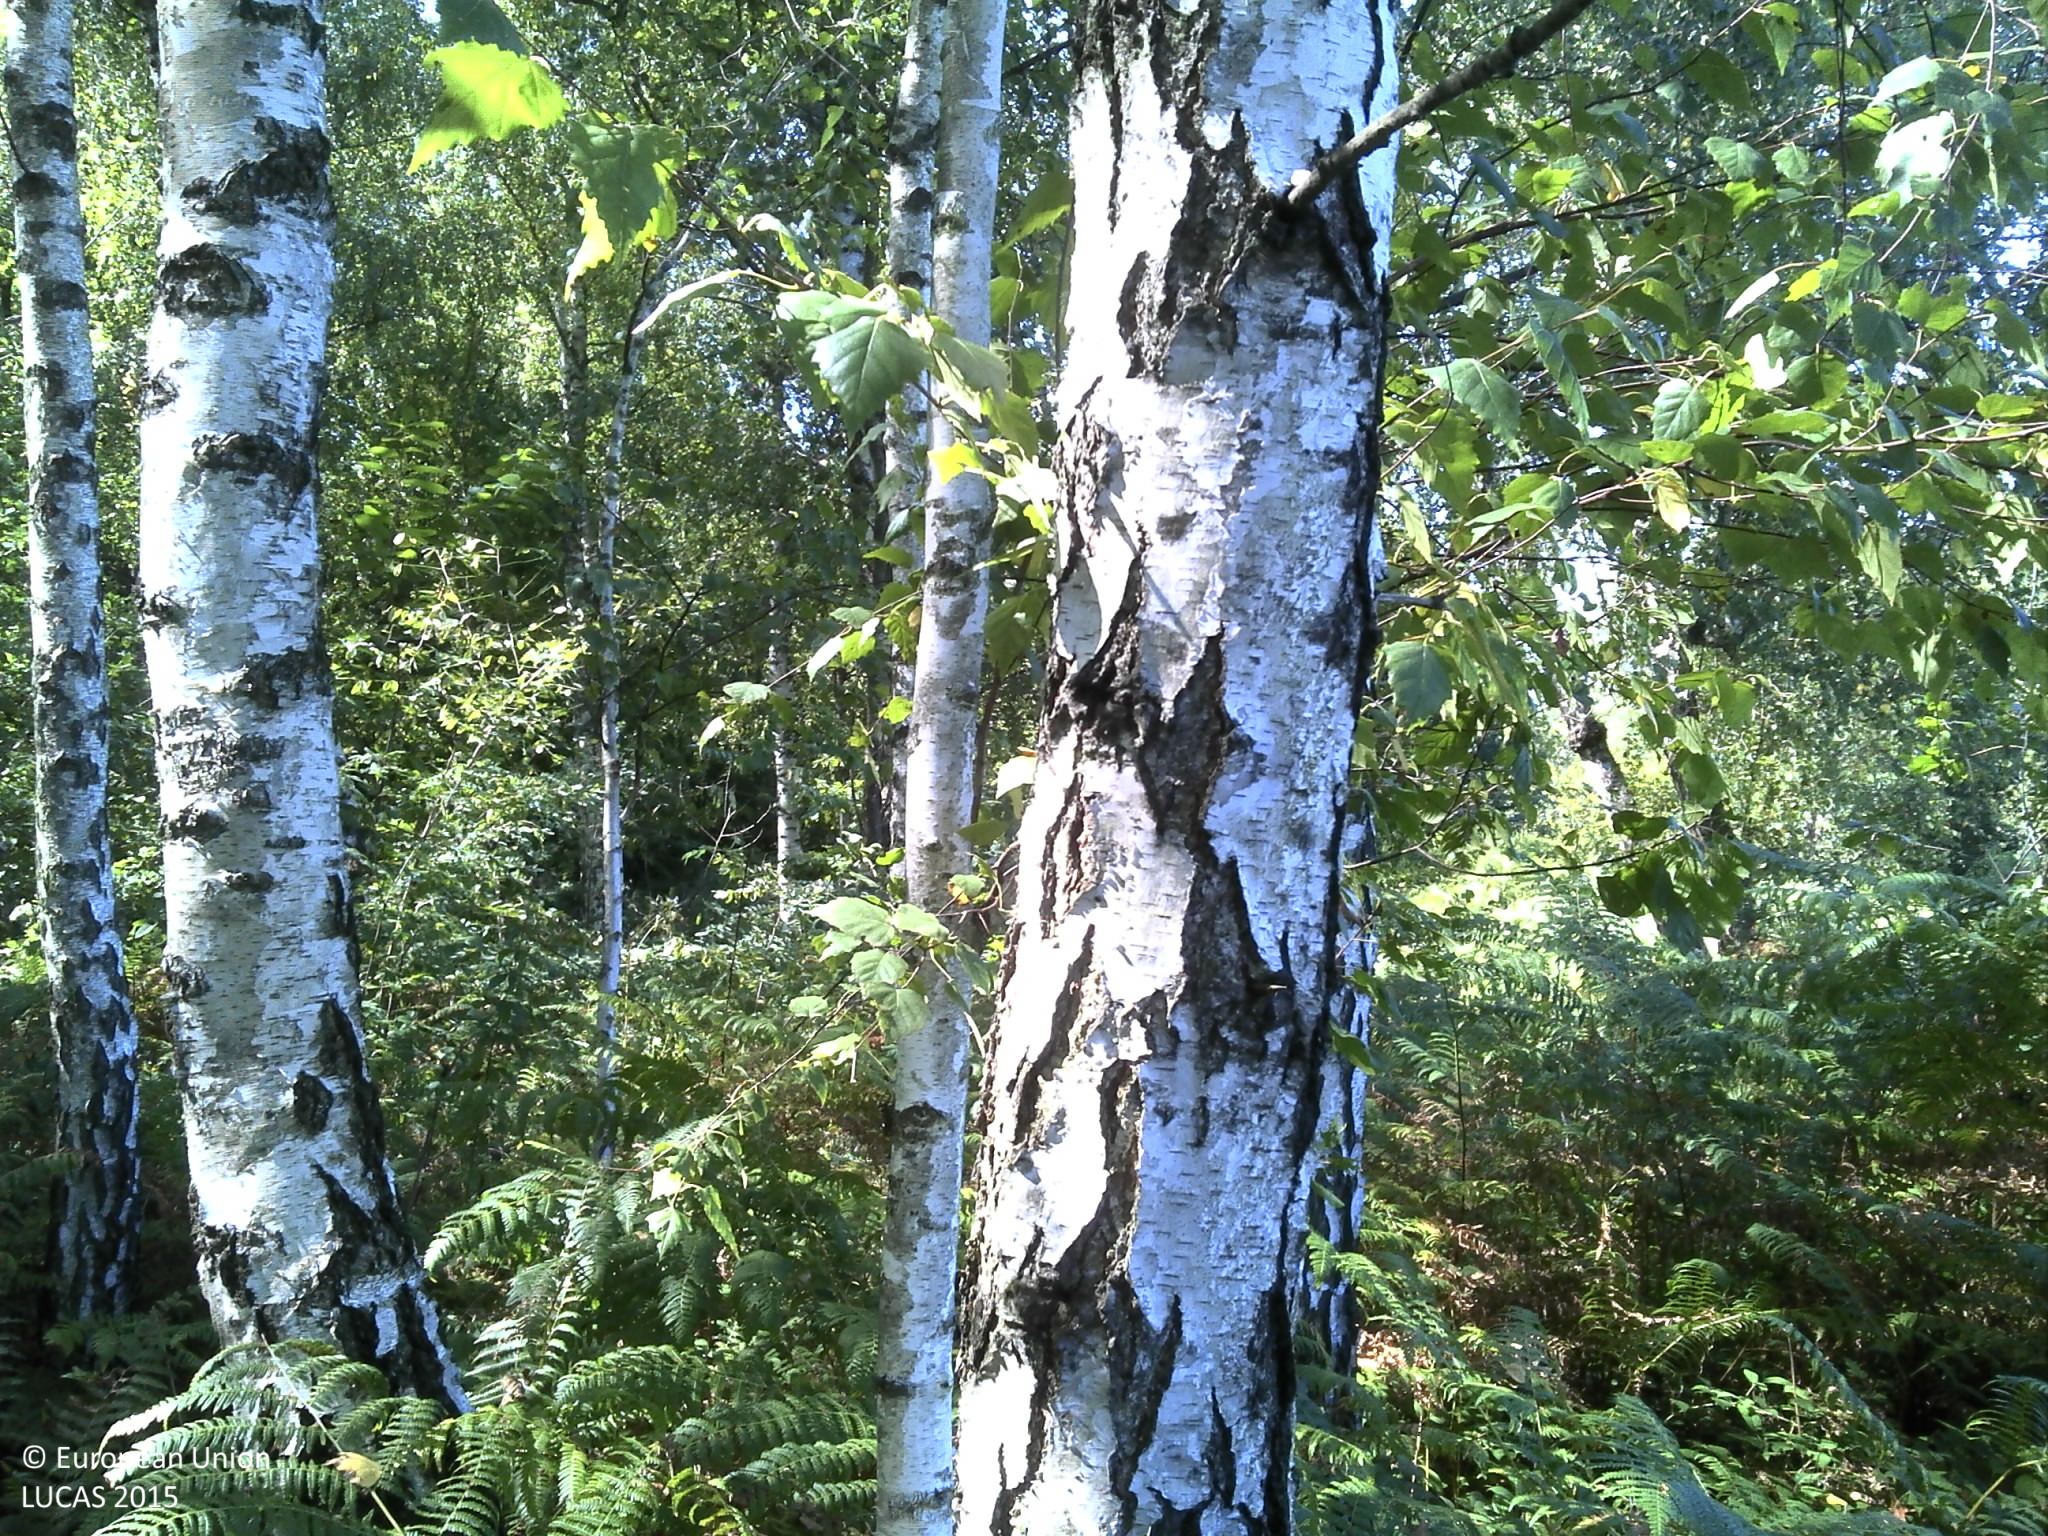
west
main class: Woodland
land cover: Broadleaved woodland
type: non-riverine alder, birch or aspen forest
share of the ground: > 75 %
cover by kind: broadleaved forest trees 100 %
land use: Forestry
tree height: > 5 m
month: August
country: HR
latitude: 45.2704
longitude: 16.4595
